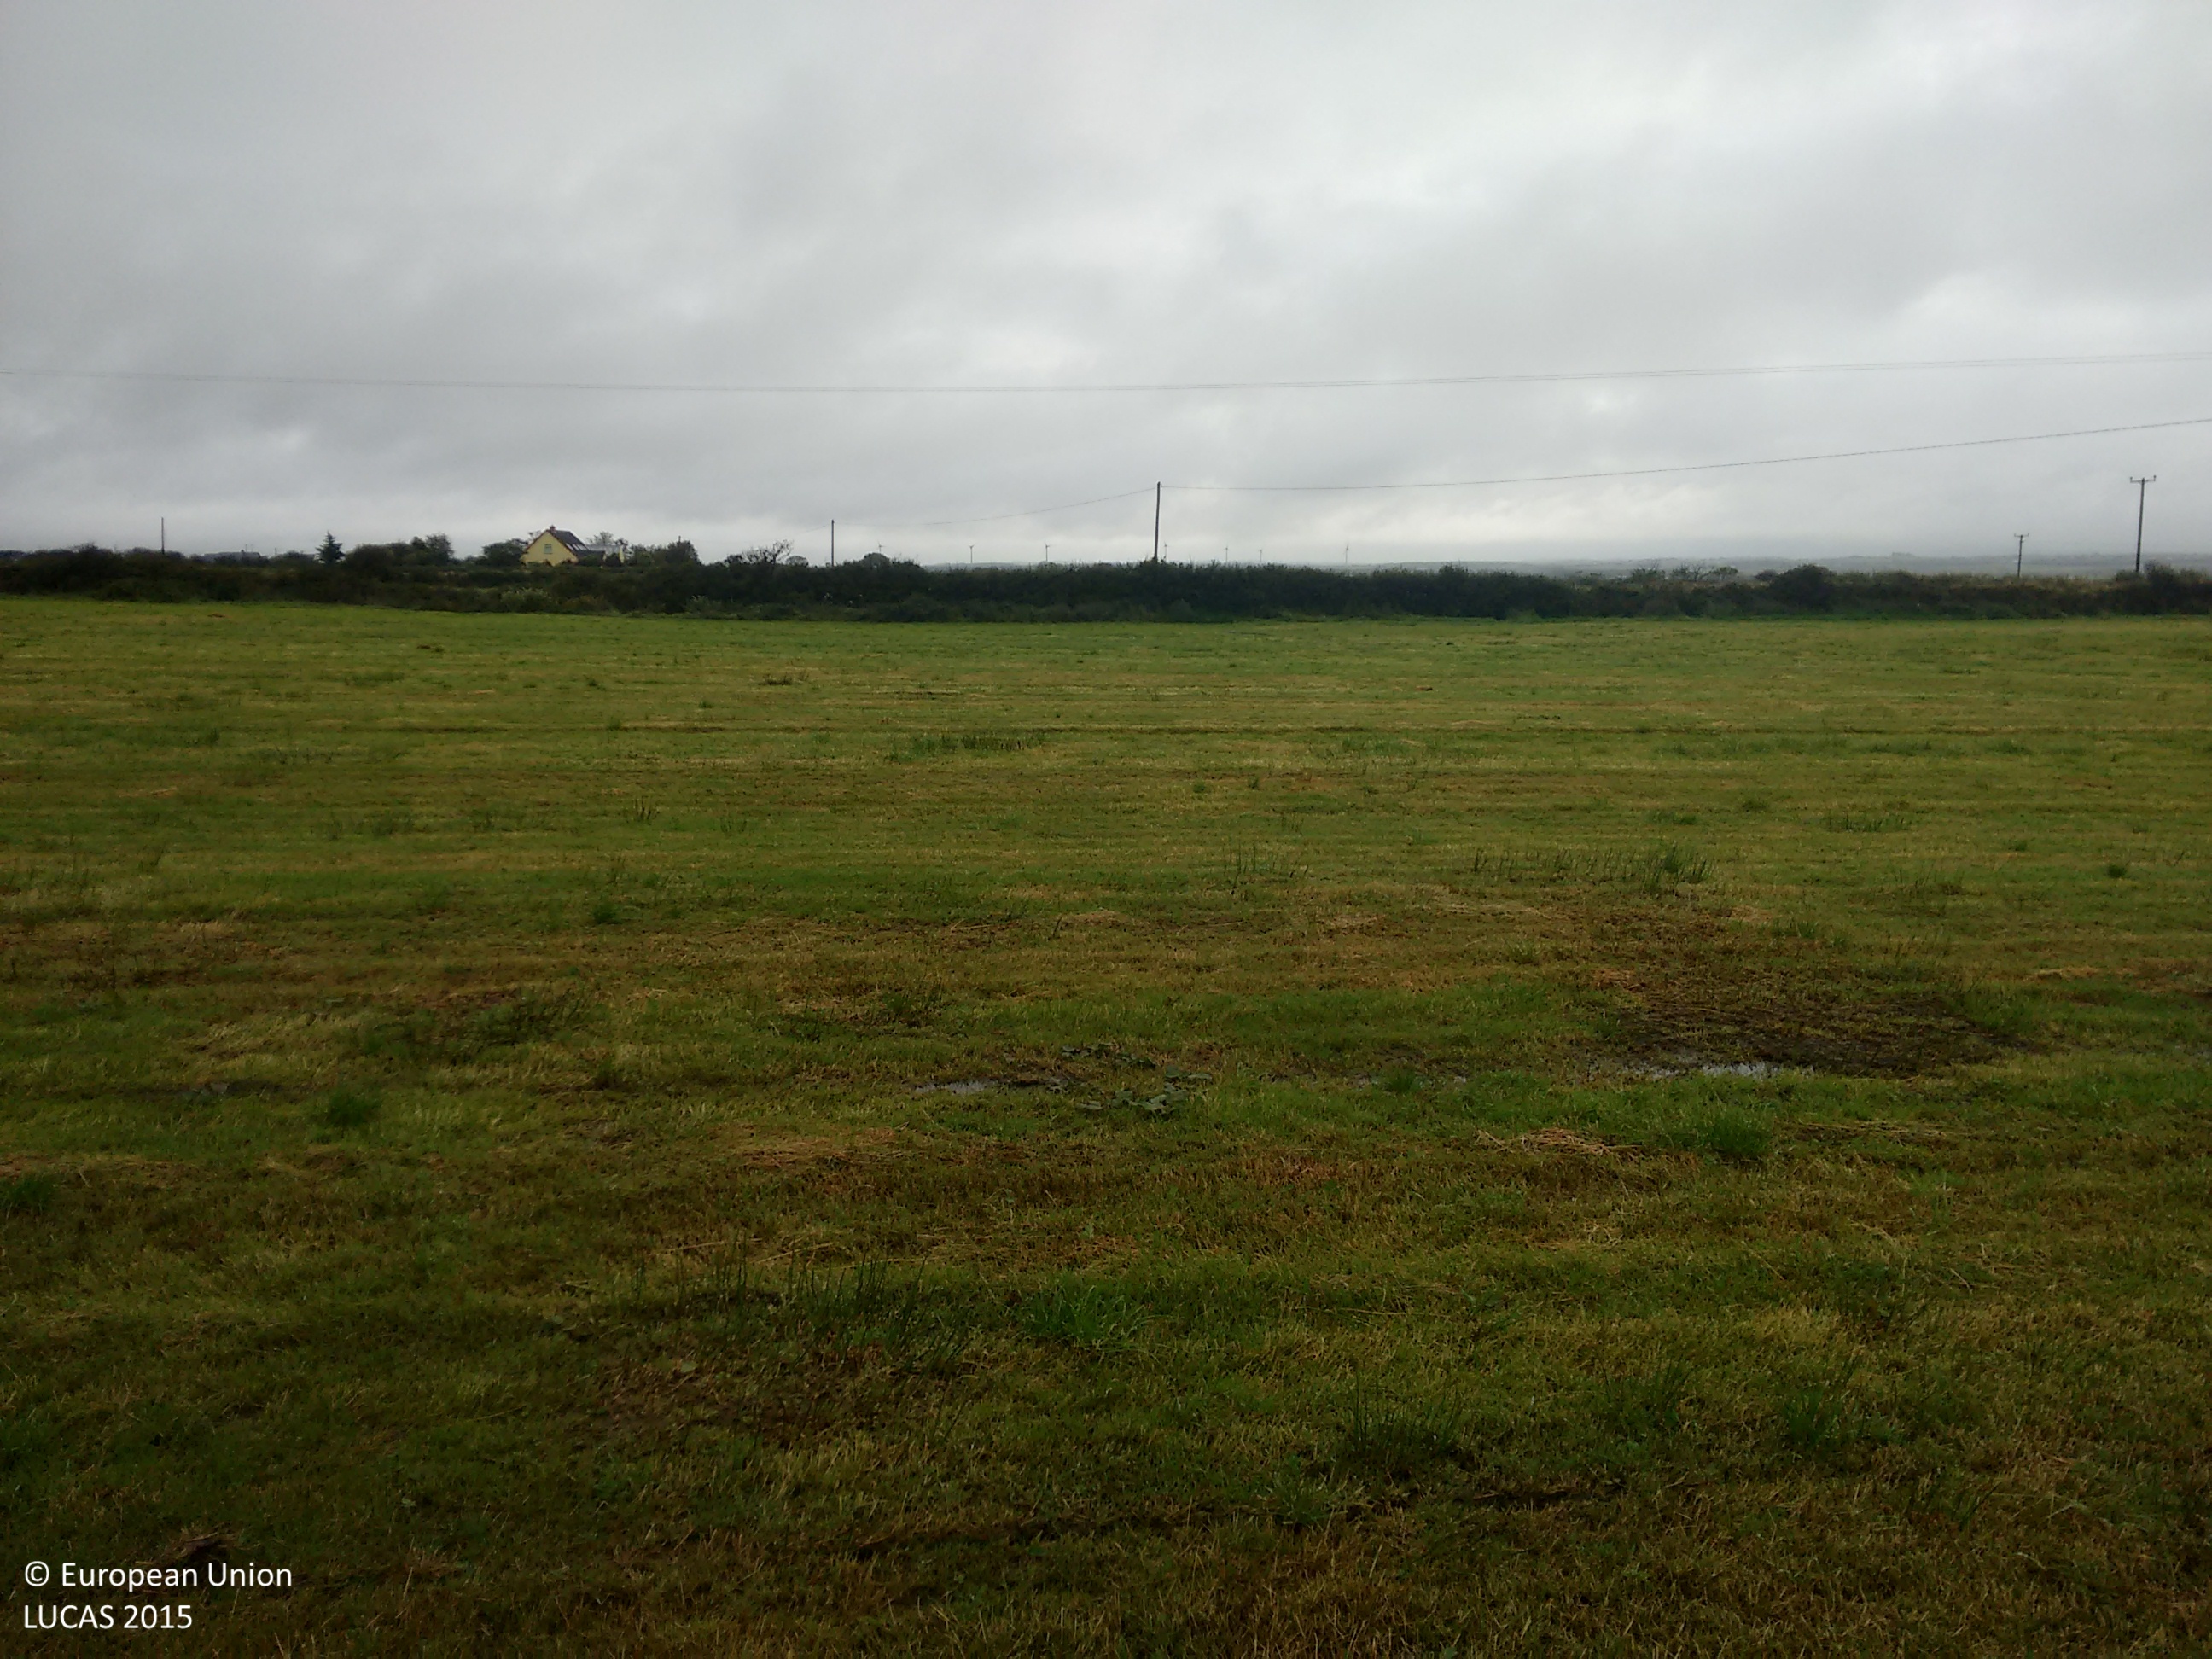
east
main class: Grassland
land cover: Grassland without tree/shrub cover
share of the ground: > 75 %
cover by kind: herbaceous plants 95 %, unconsolidated bare surface 5 %
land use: Agriculture (excluding fallow land and kitchen gardens)
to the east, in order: Grassland without tree/shrub cover; Electric lines; Grassland without tree/shrub cover; Abandoned hedges; Grassland without tree/shrub cover; Electric lines; Grassland without tree/shrub cover; Abandoned hedges; Grassland without tree/shrub cover
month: September
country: IE
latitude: 52.6717
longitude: -9.5644
